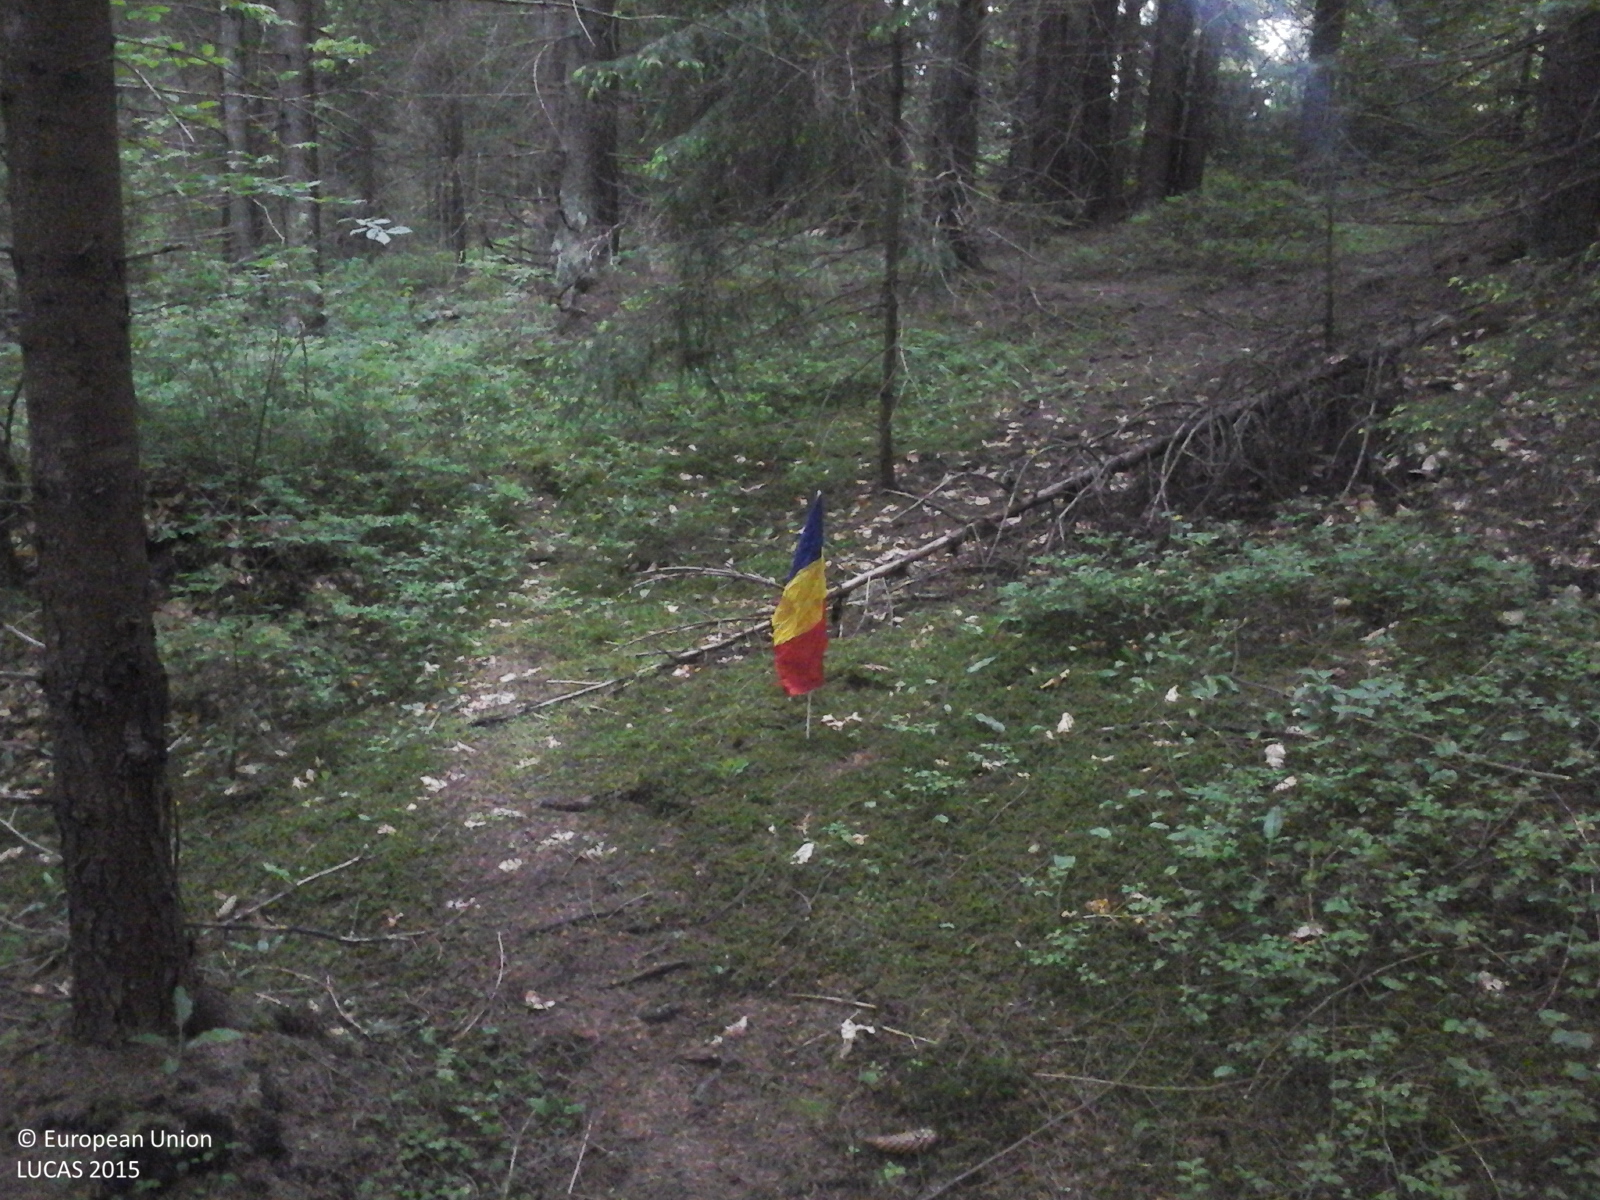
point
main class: Woodland
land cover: Spruce dominated coniferous woodland
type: alpine coniferous forest
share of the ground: > 75 %
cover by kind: coniferous forest trees 100 %
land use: Forestry
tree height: > 5 m
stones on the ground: < 10 %
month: June
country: RO
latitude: 47.3439
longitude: 25.0751
